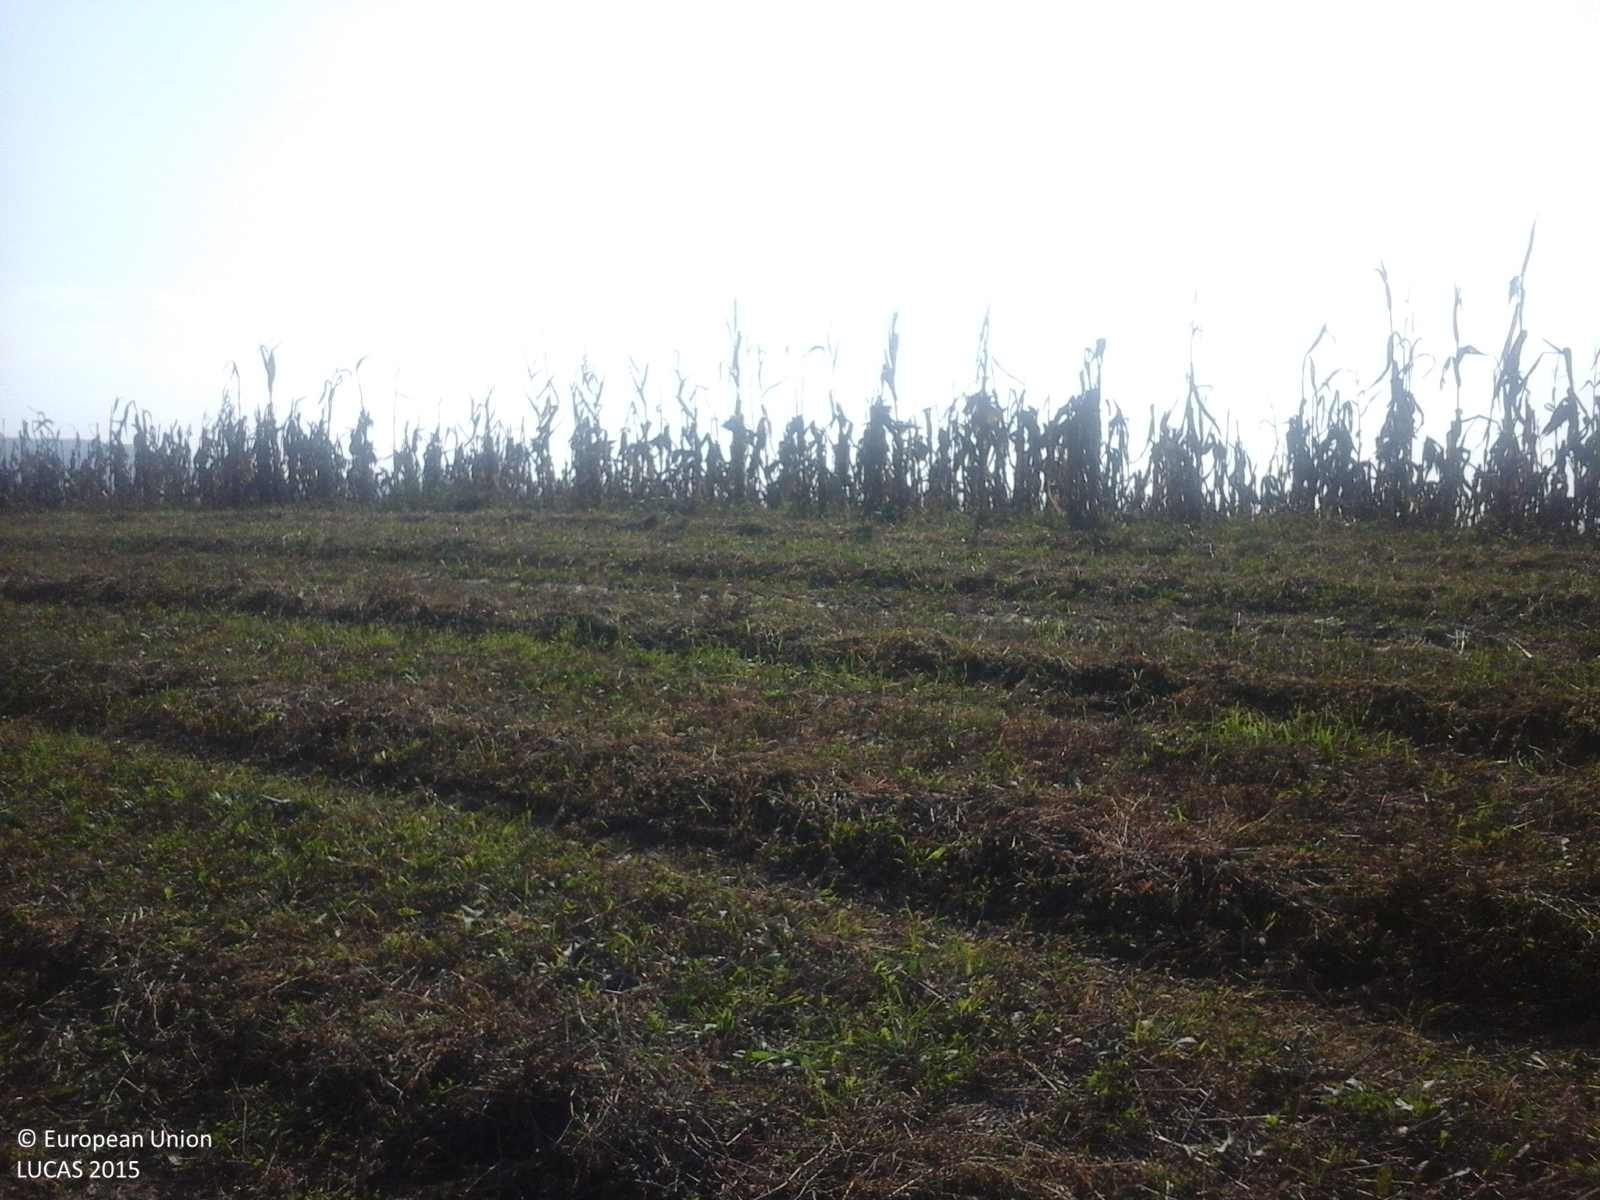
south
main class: Cropland
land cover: Lucerne
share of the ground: > 75 %
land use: Agriculture (excluding fallow land and kitchen gardens)
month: October
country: RO
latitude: 46.5773
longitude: 24.3997
